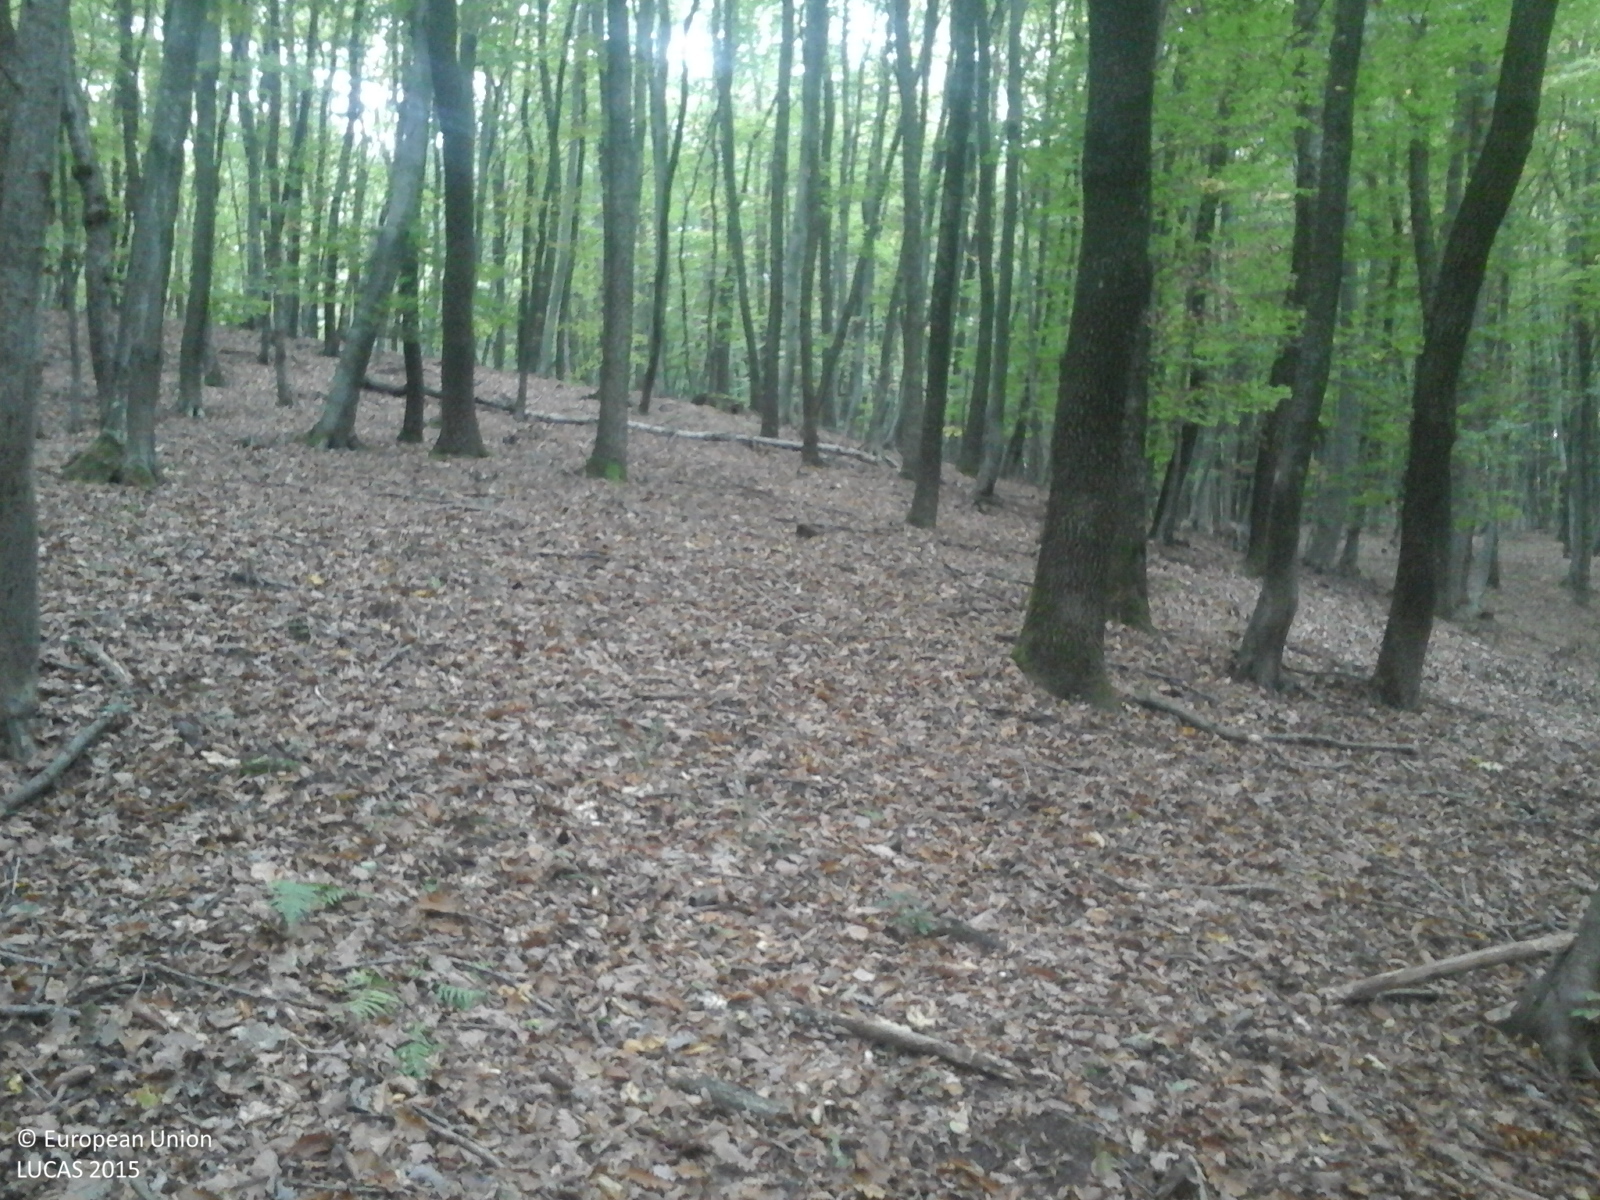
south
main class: Woodland
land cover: Broadleaved woodland
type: acidophilous oak and oak-birch forest
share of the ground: > 75 %
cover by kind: broadleaved forest trees 100 %
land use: Forestry
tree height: > 5 m
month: October
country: RO
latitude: 46.1333
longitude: 24.8338
